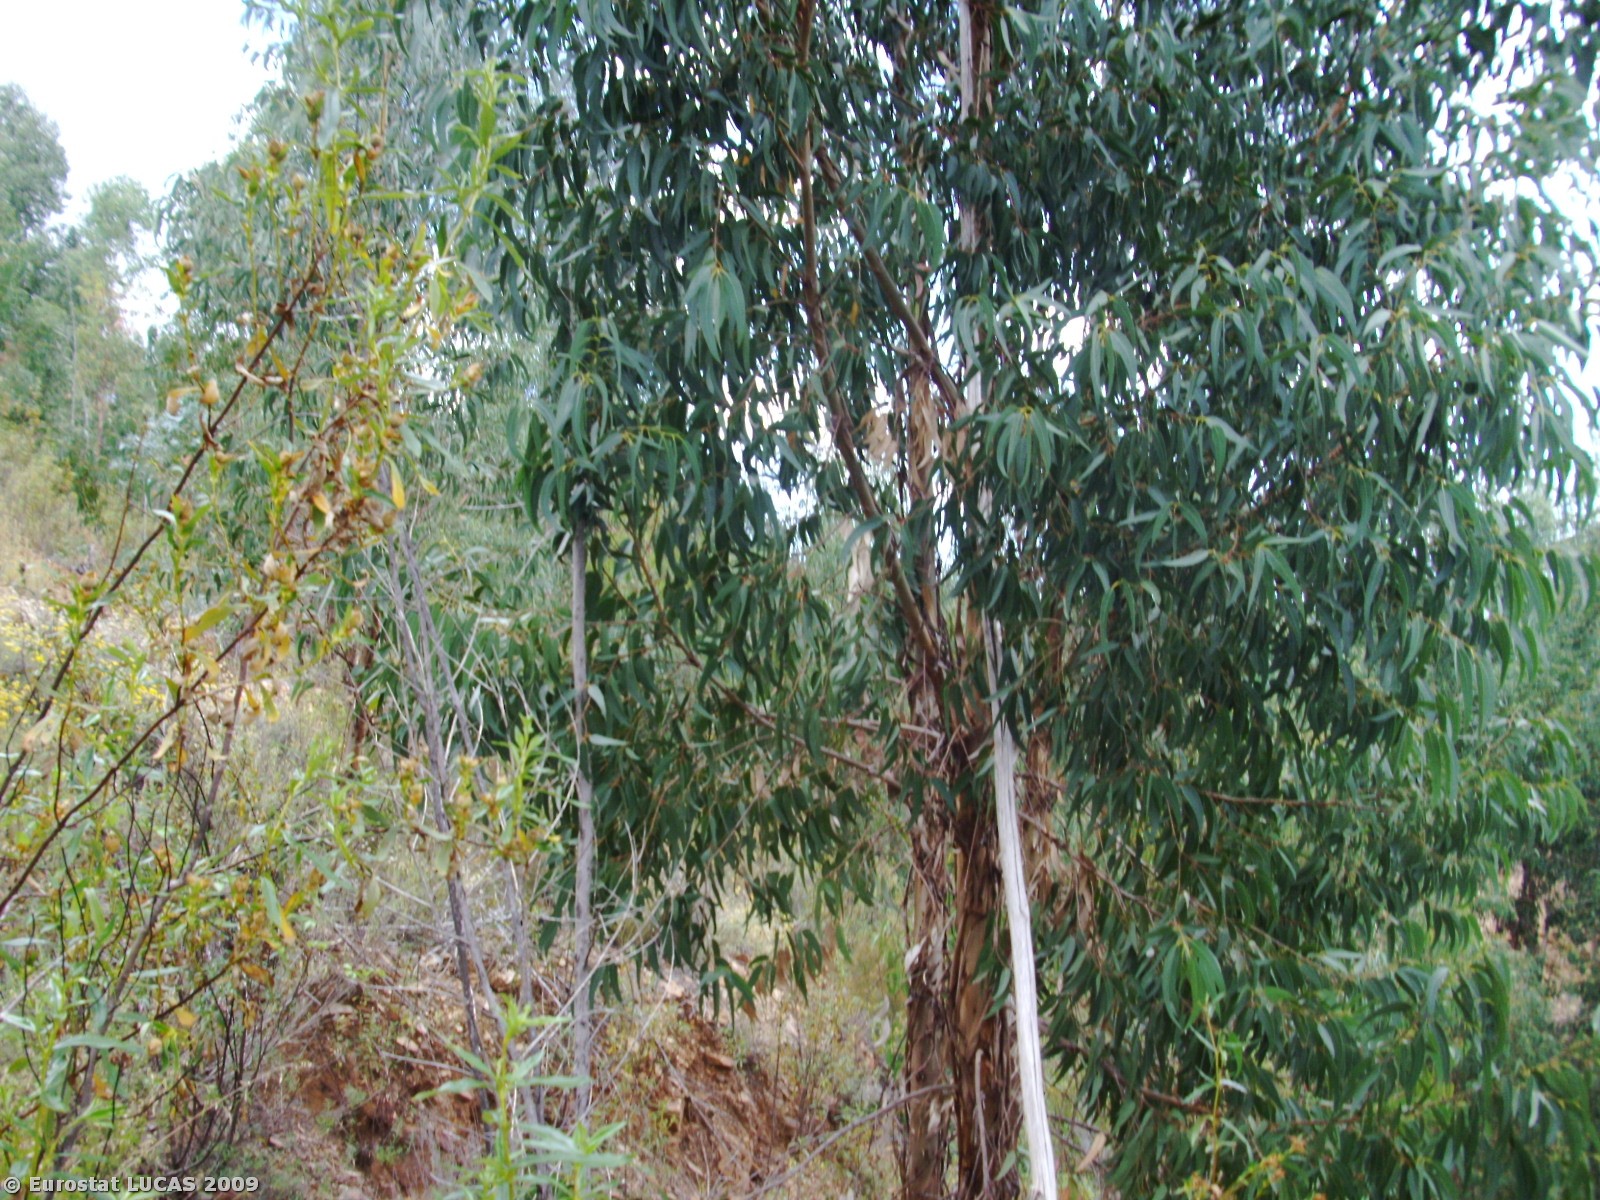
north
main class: Woodland
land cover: Broadleaved woodland
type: plantations and self-sown exotic forest
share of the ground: 25 - 50 %
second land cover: Shrubland with sparse tree cover
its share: 25 - 50 %
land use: Forestry
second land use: Unused
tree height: > 5 m
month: June
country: PT
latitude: 37.2400
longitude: -8.4563
